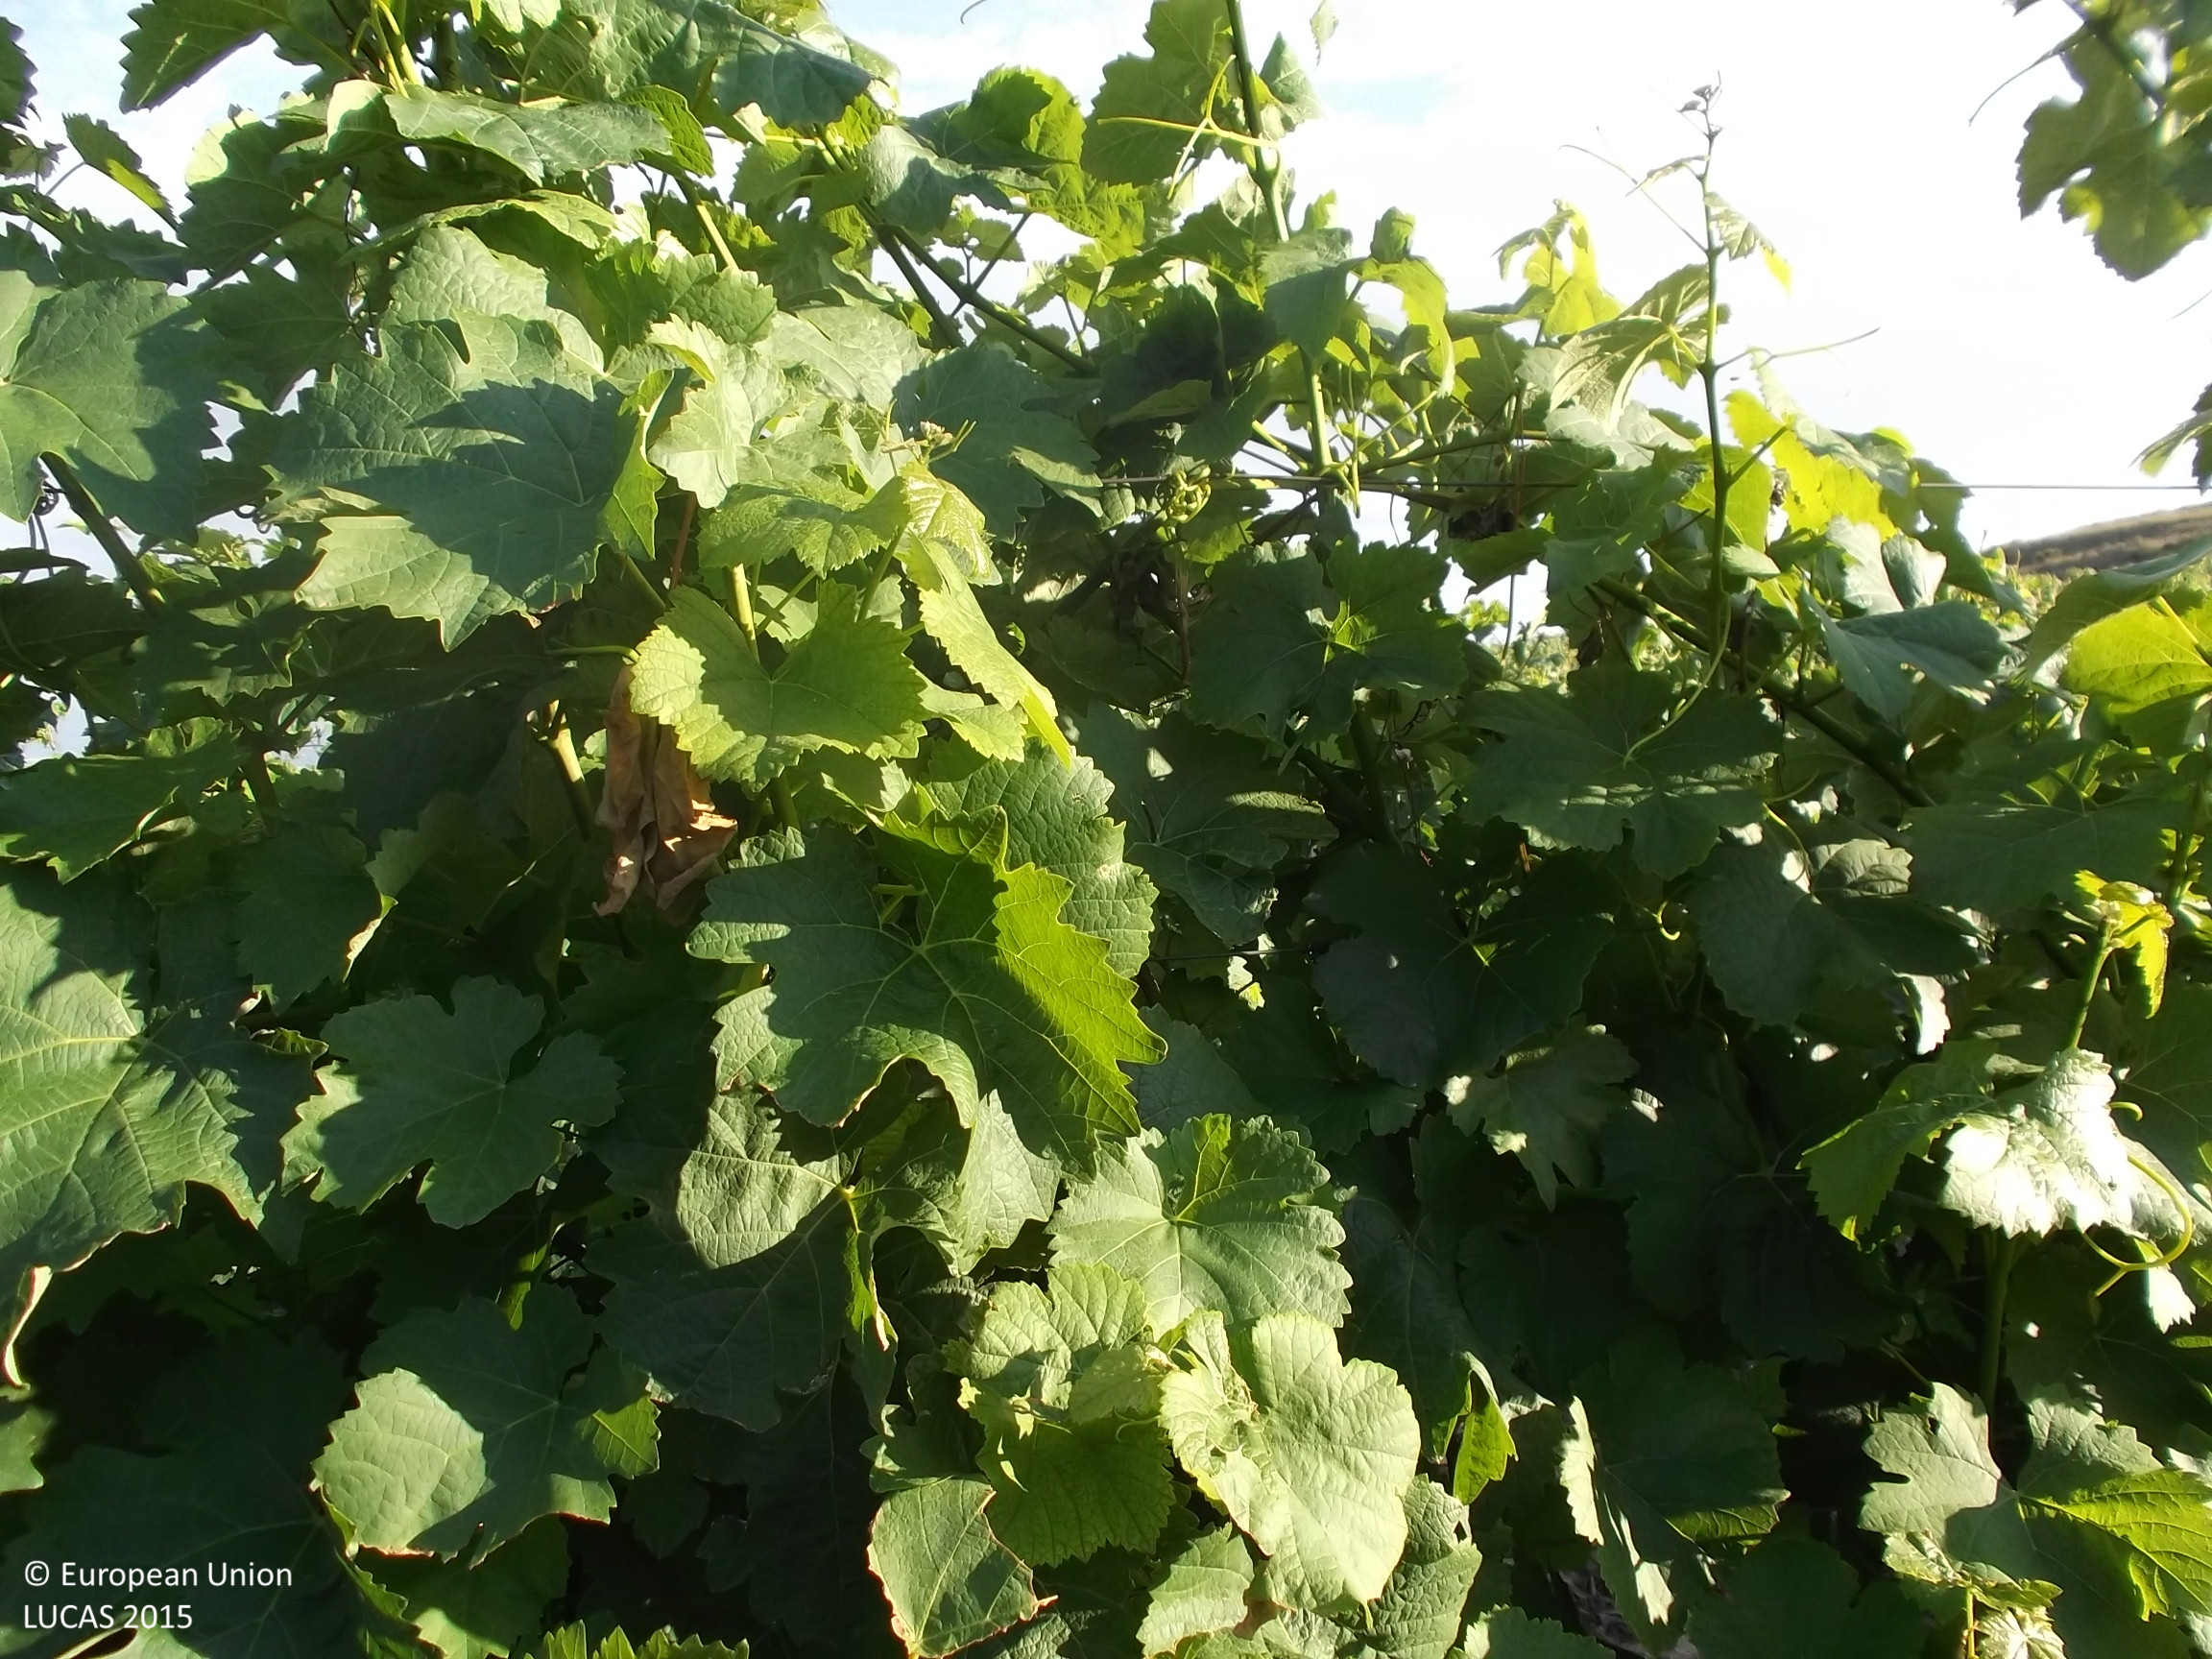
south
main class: Cropland
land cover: Vineyards
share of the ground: 10 - 25 %
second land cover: Spontaneously vegetated surfaces
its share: 25 - 50 %
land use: Agriculture (excluding fallow land and kitchen gardens)
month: June
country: ES
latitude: 42.3639
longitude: -2.0970
